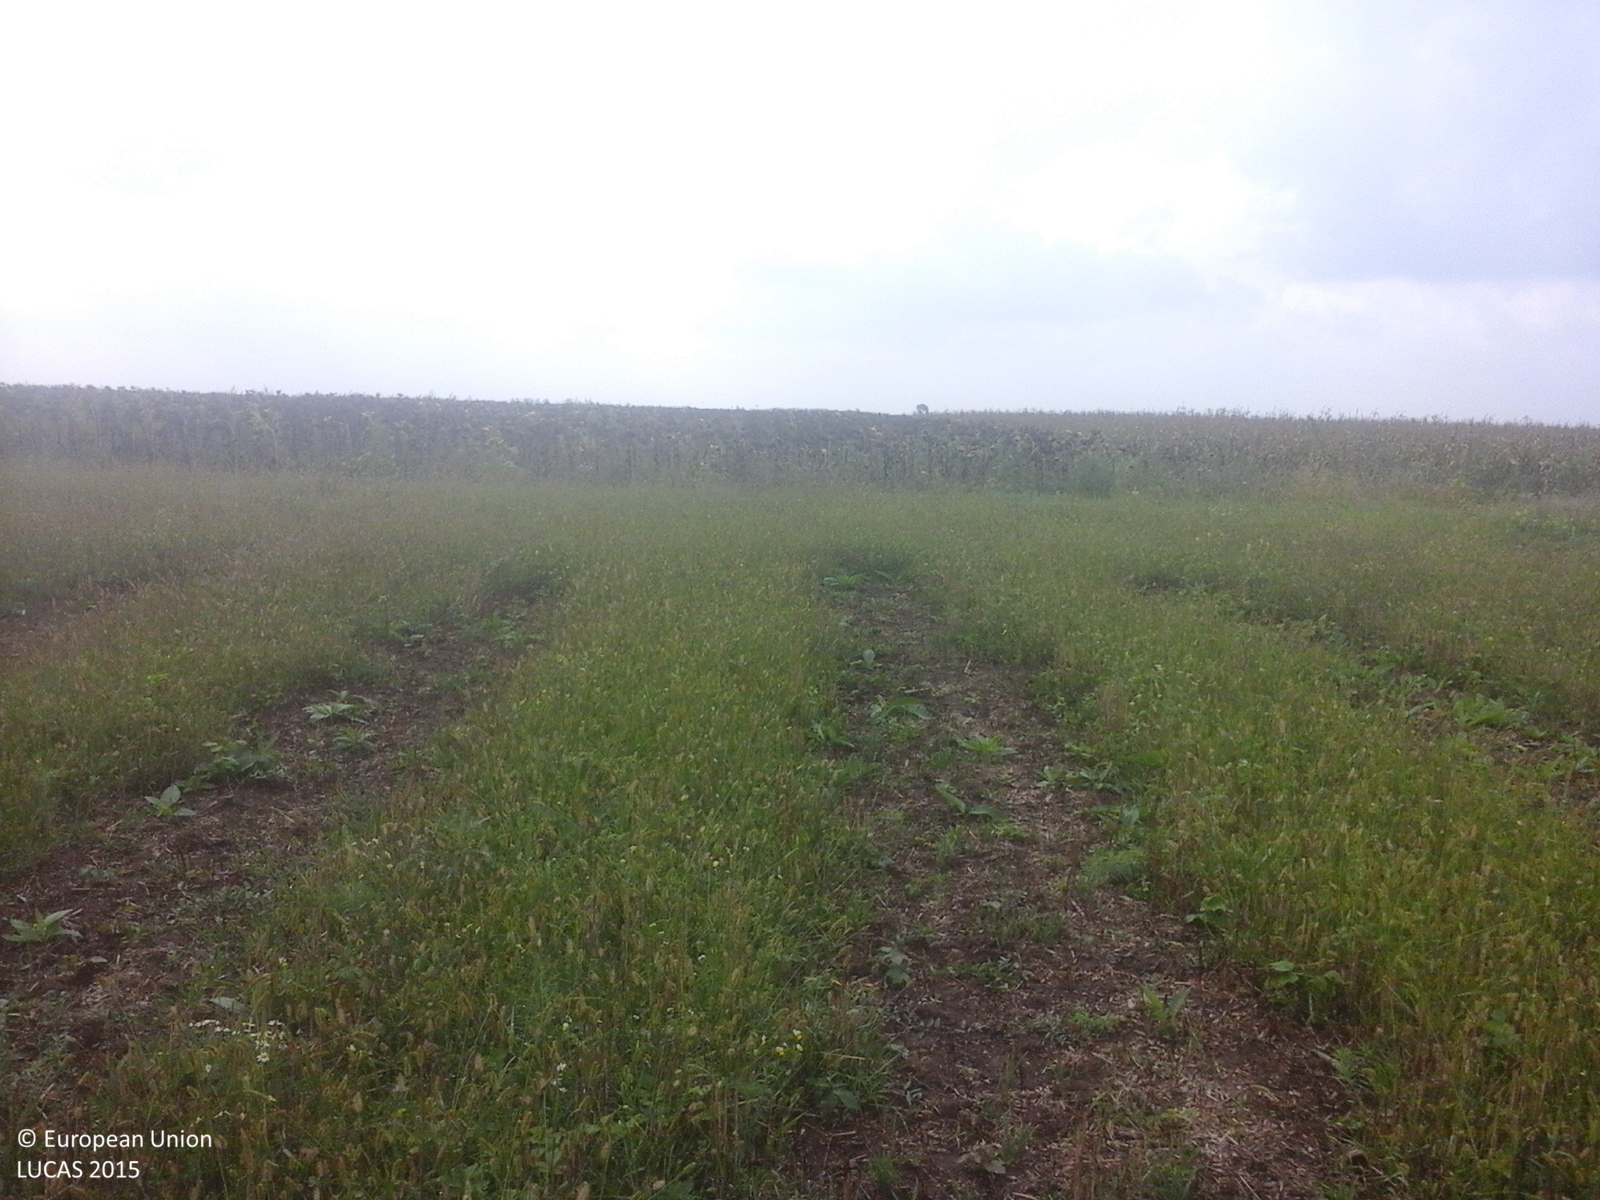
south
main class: Cropland
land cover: Common wheat
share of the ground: 10 - 25 %
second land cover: Spontaneously vegetated surfaces
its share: 25 - 50 %
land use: Agriculture (excluding fallow land and kitchen gardens)
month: September
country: RO
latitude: 46.7643
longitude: 21.8411
